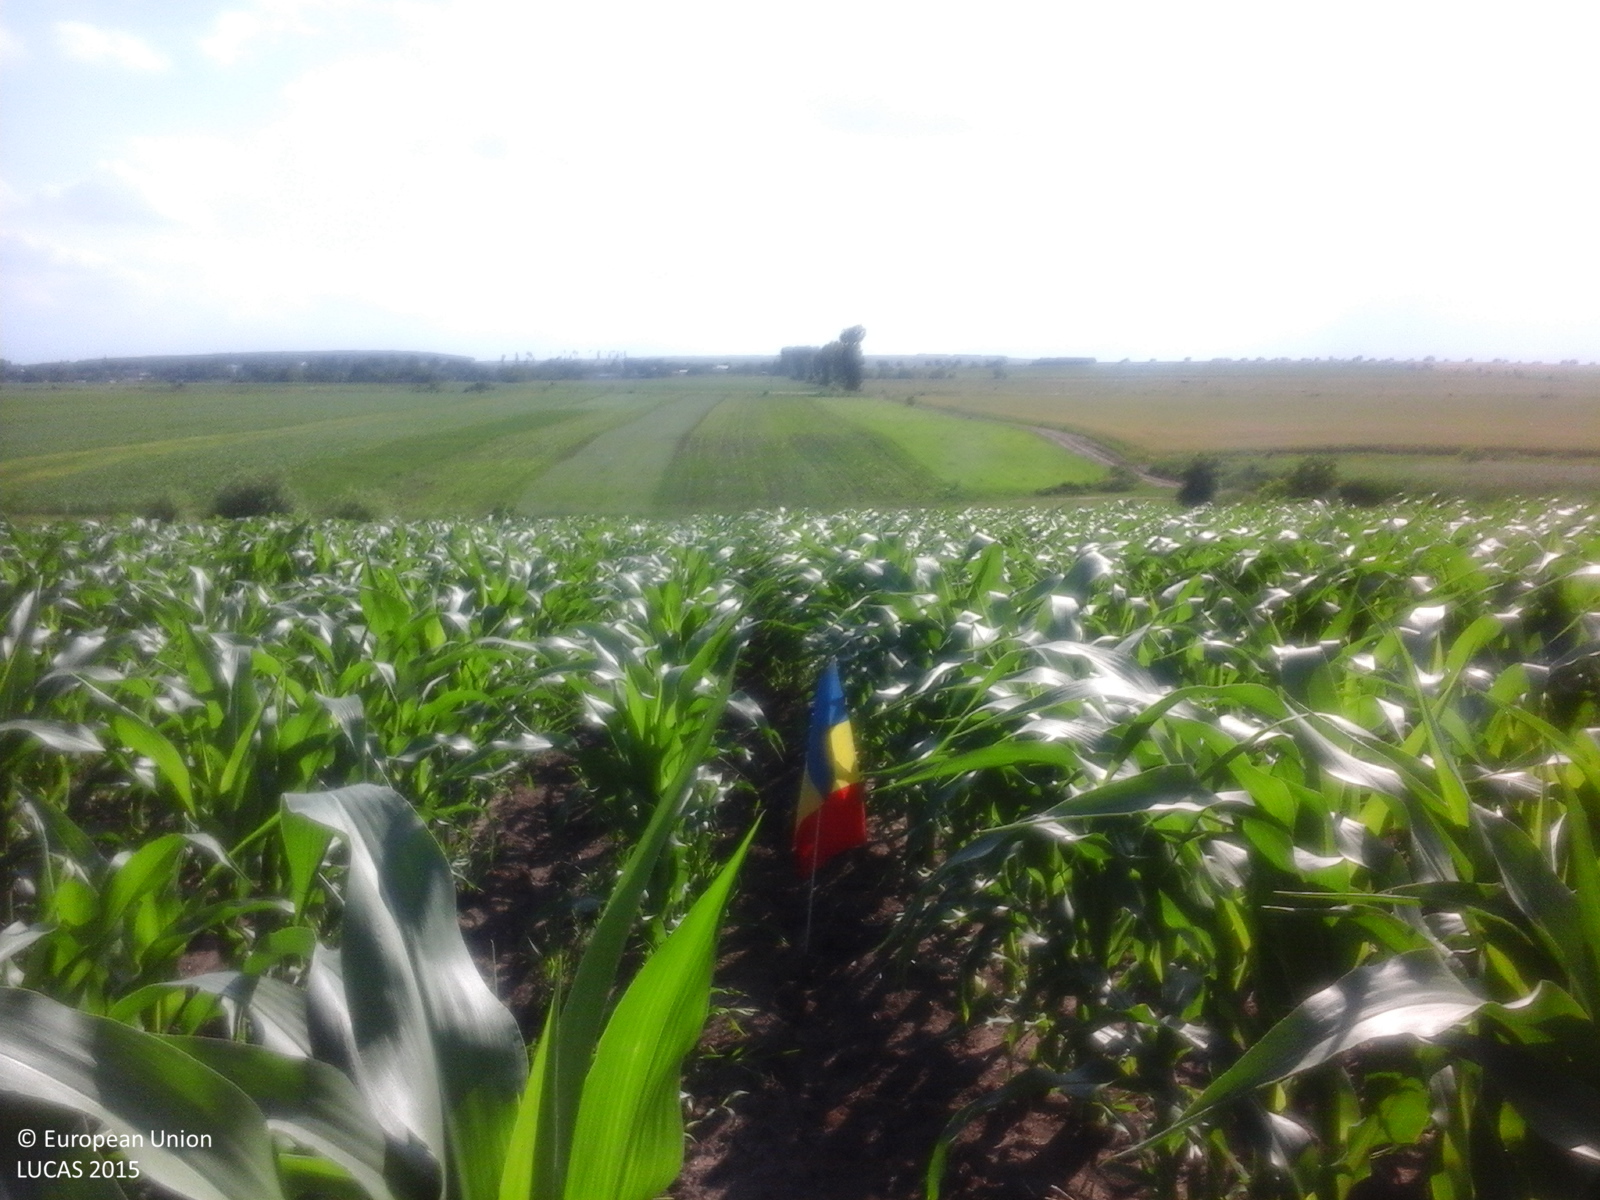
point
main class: Cropland
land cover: Maize
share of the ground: > 75 %
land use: Agriculture (excluding fallow land and kitchen gardens)
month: June
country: RO
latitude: 47.8734
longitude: 26.4687
